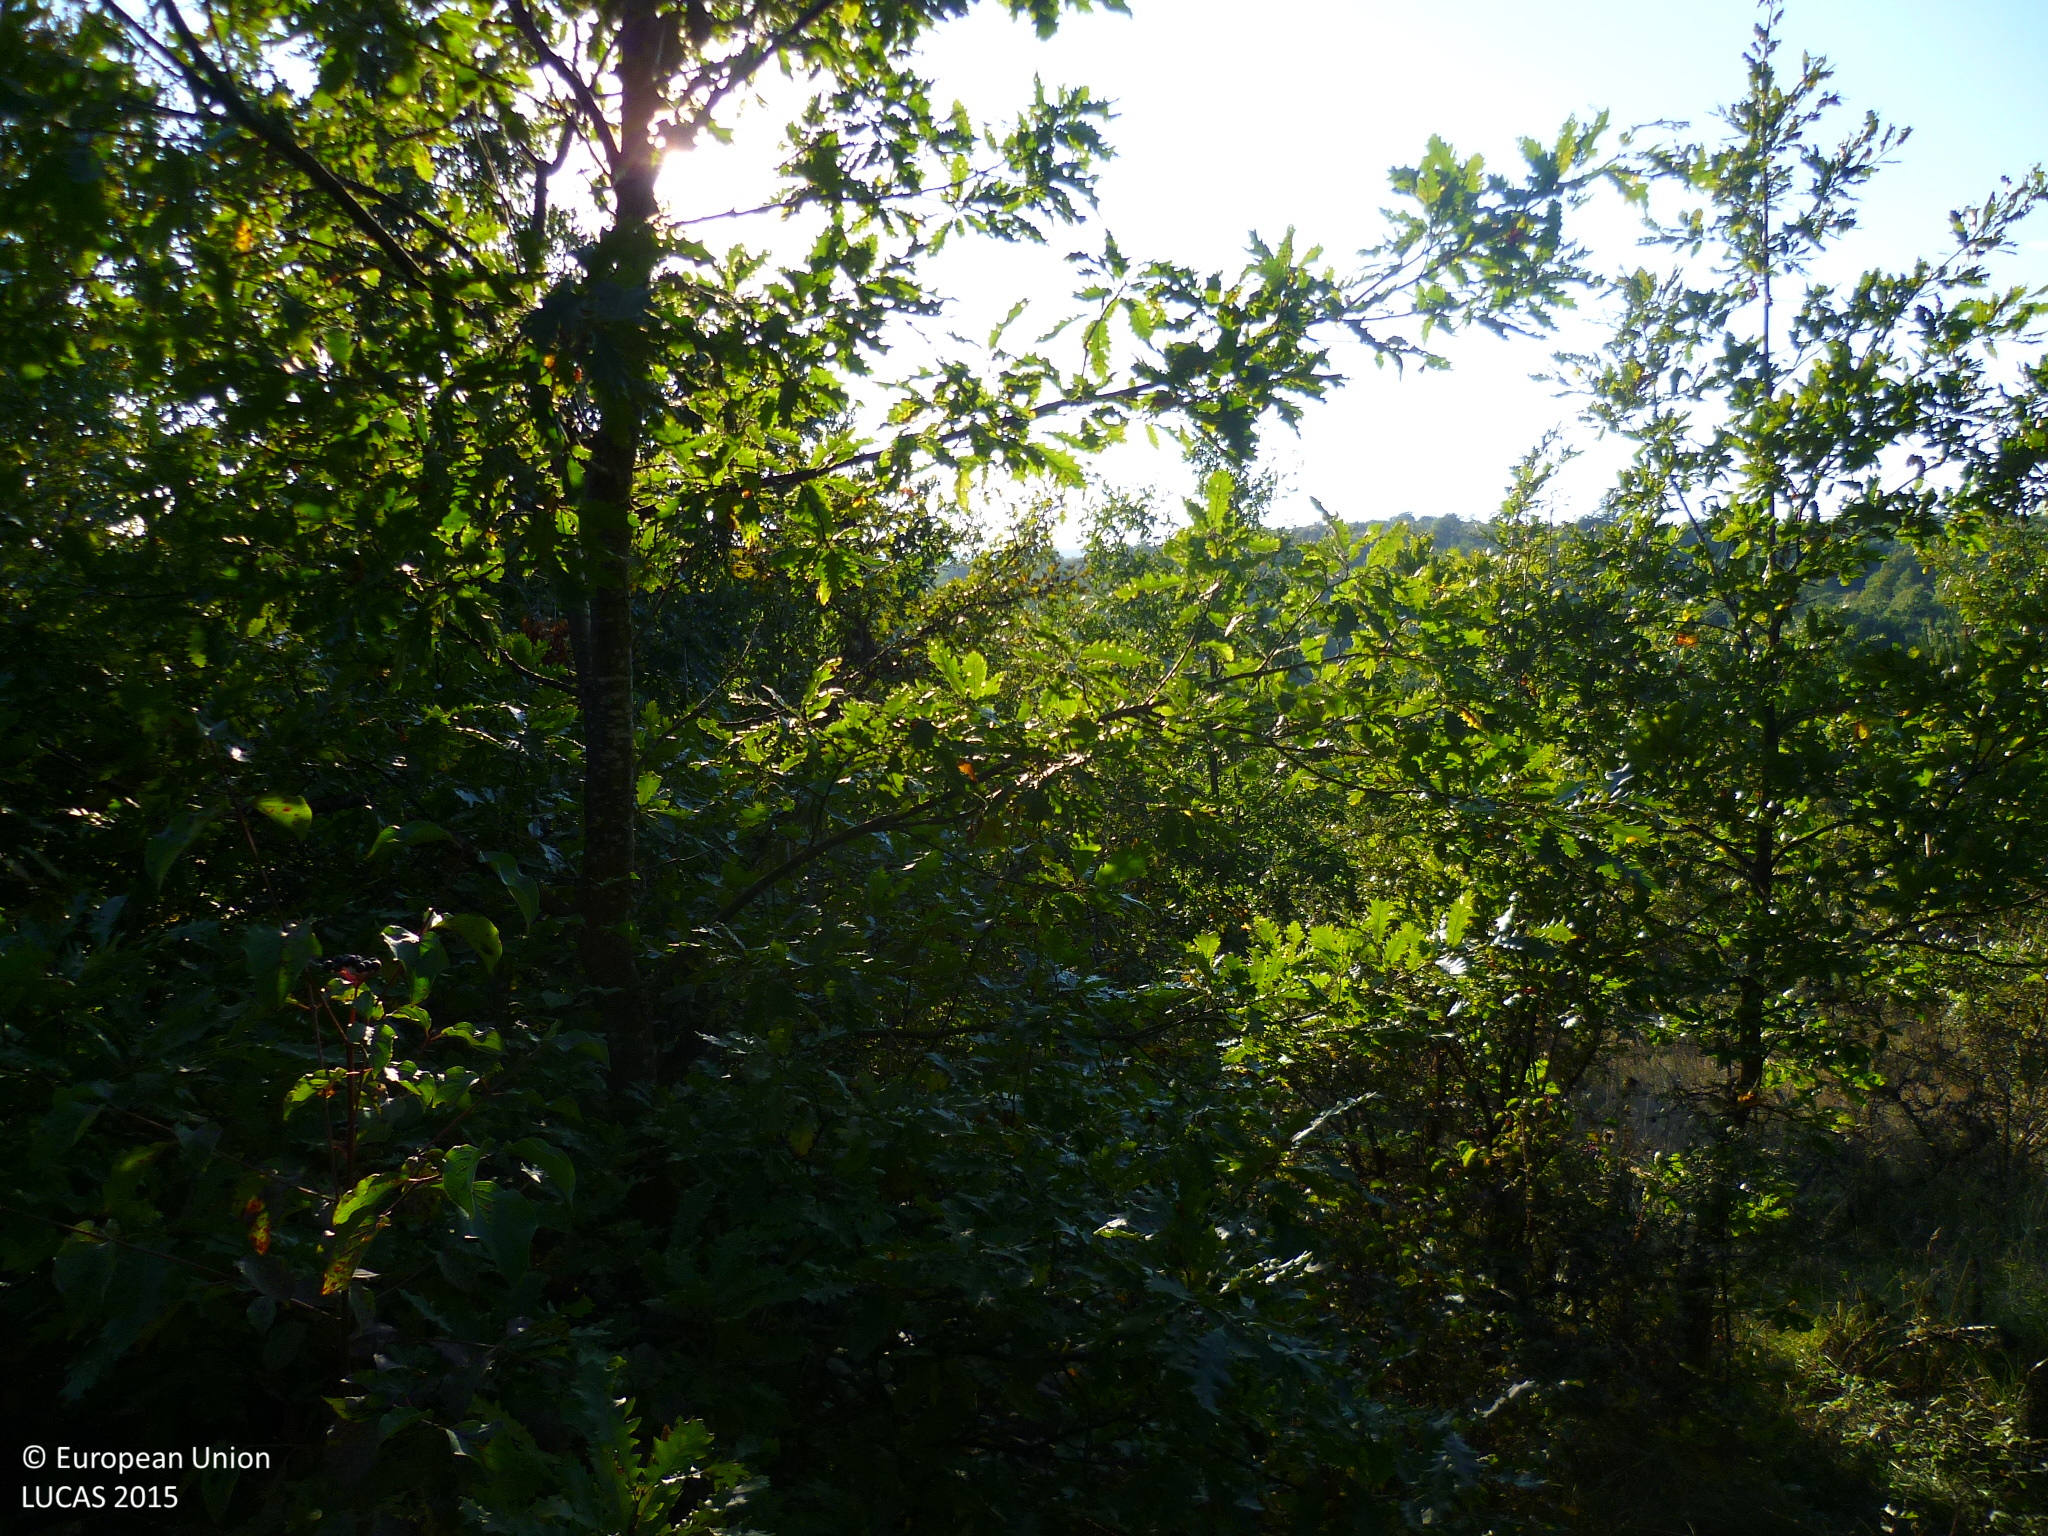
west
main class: Woodland
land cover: Broadleaved woodland
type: mesophytic deciduous forest
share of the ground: 50 - 75 %
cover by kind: broadleaved forest trees 60 %, herbaceous plants 15 %, coniferous forest trees 10 %, shrubs 10 %, unconsolidated bare surface 5 %
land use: Semi-natural and natural areas not in use
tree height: > 5 m
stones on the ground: 25 - 50 %
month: October
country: BG
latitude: 43.0414
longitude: 22.9580
